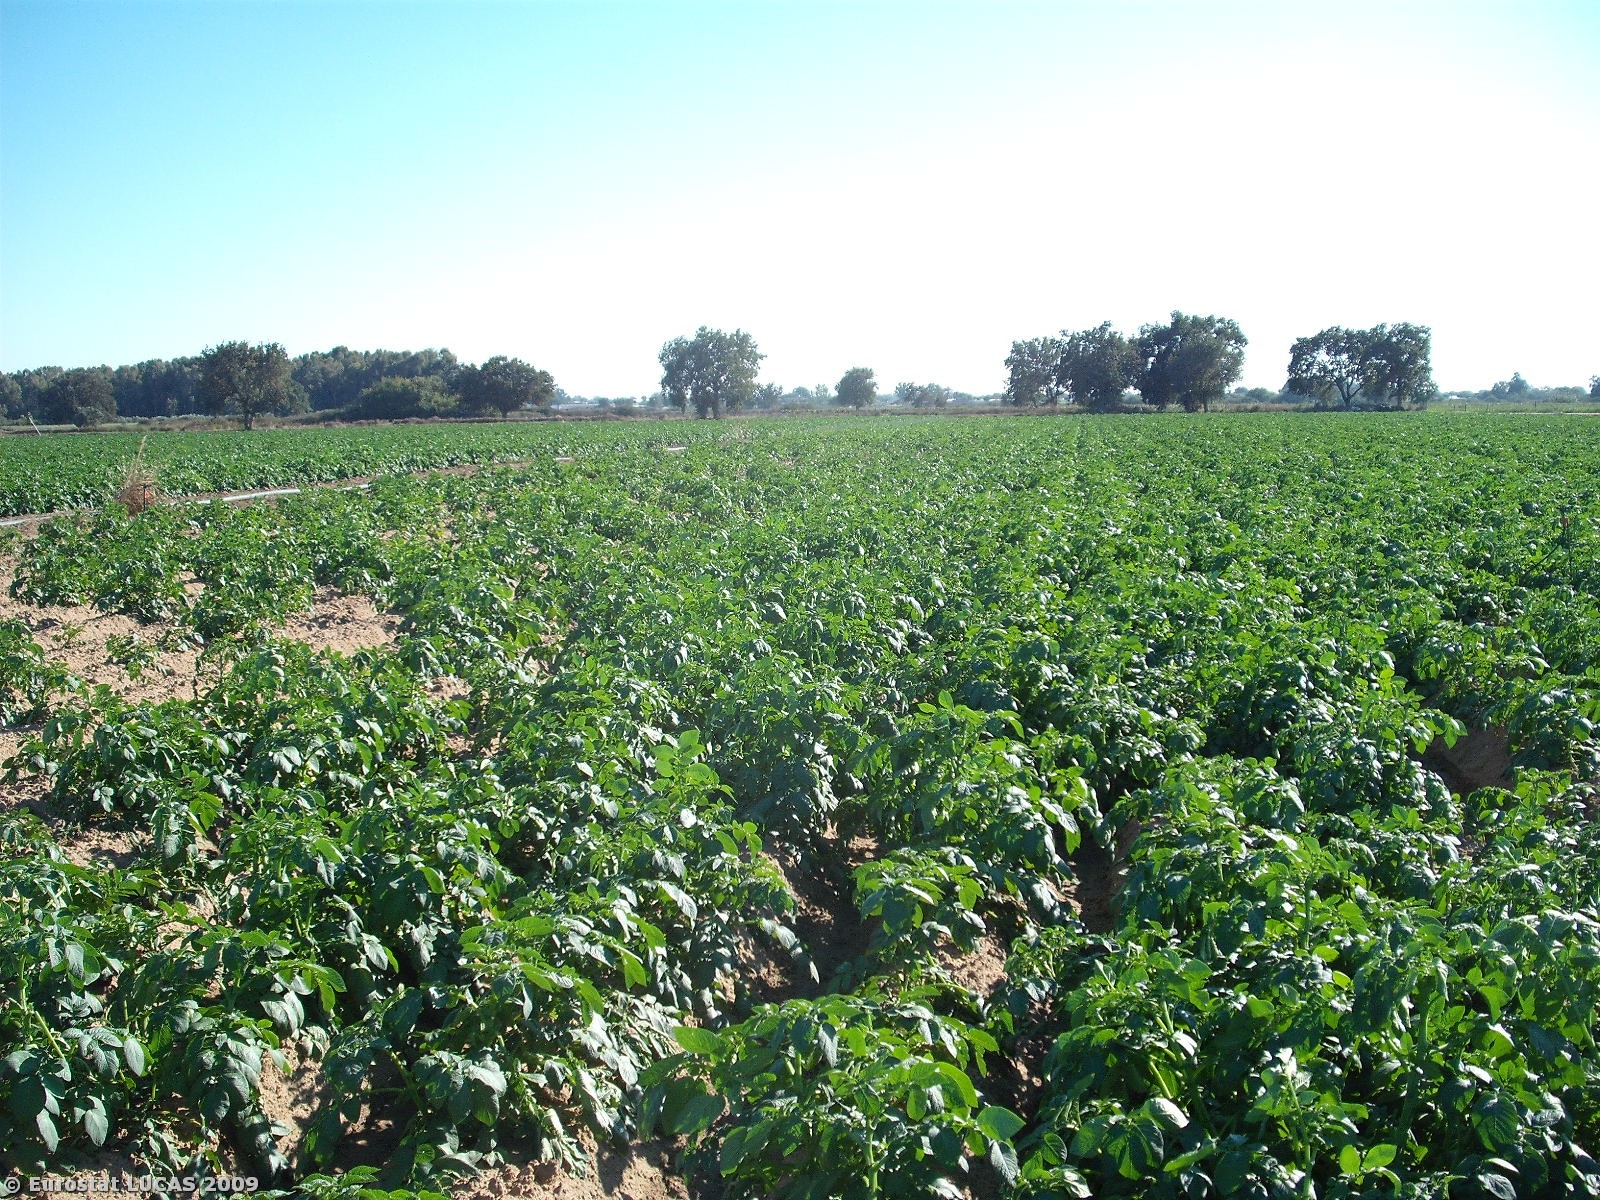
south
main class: Cropland
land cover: Potatoes
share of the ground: 50 - 75 %
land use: Agriculture (excluding fallow land and kitchen gardens)
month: October
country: GR
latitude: 38.1021
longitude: 21.4018
